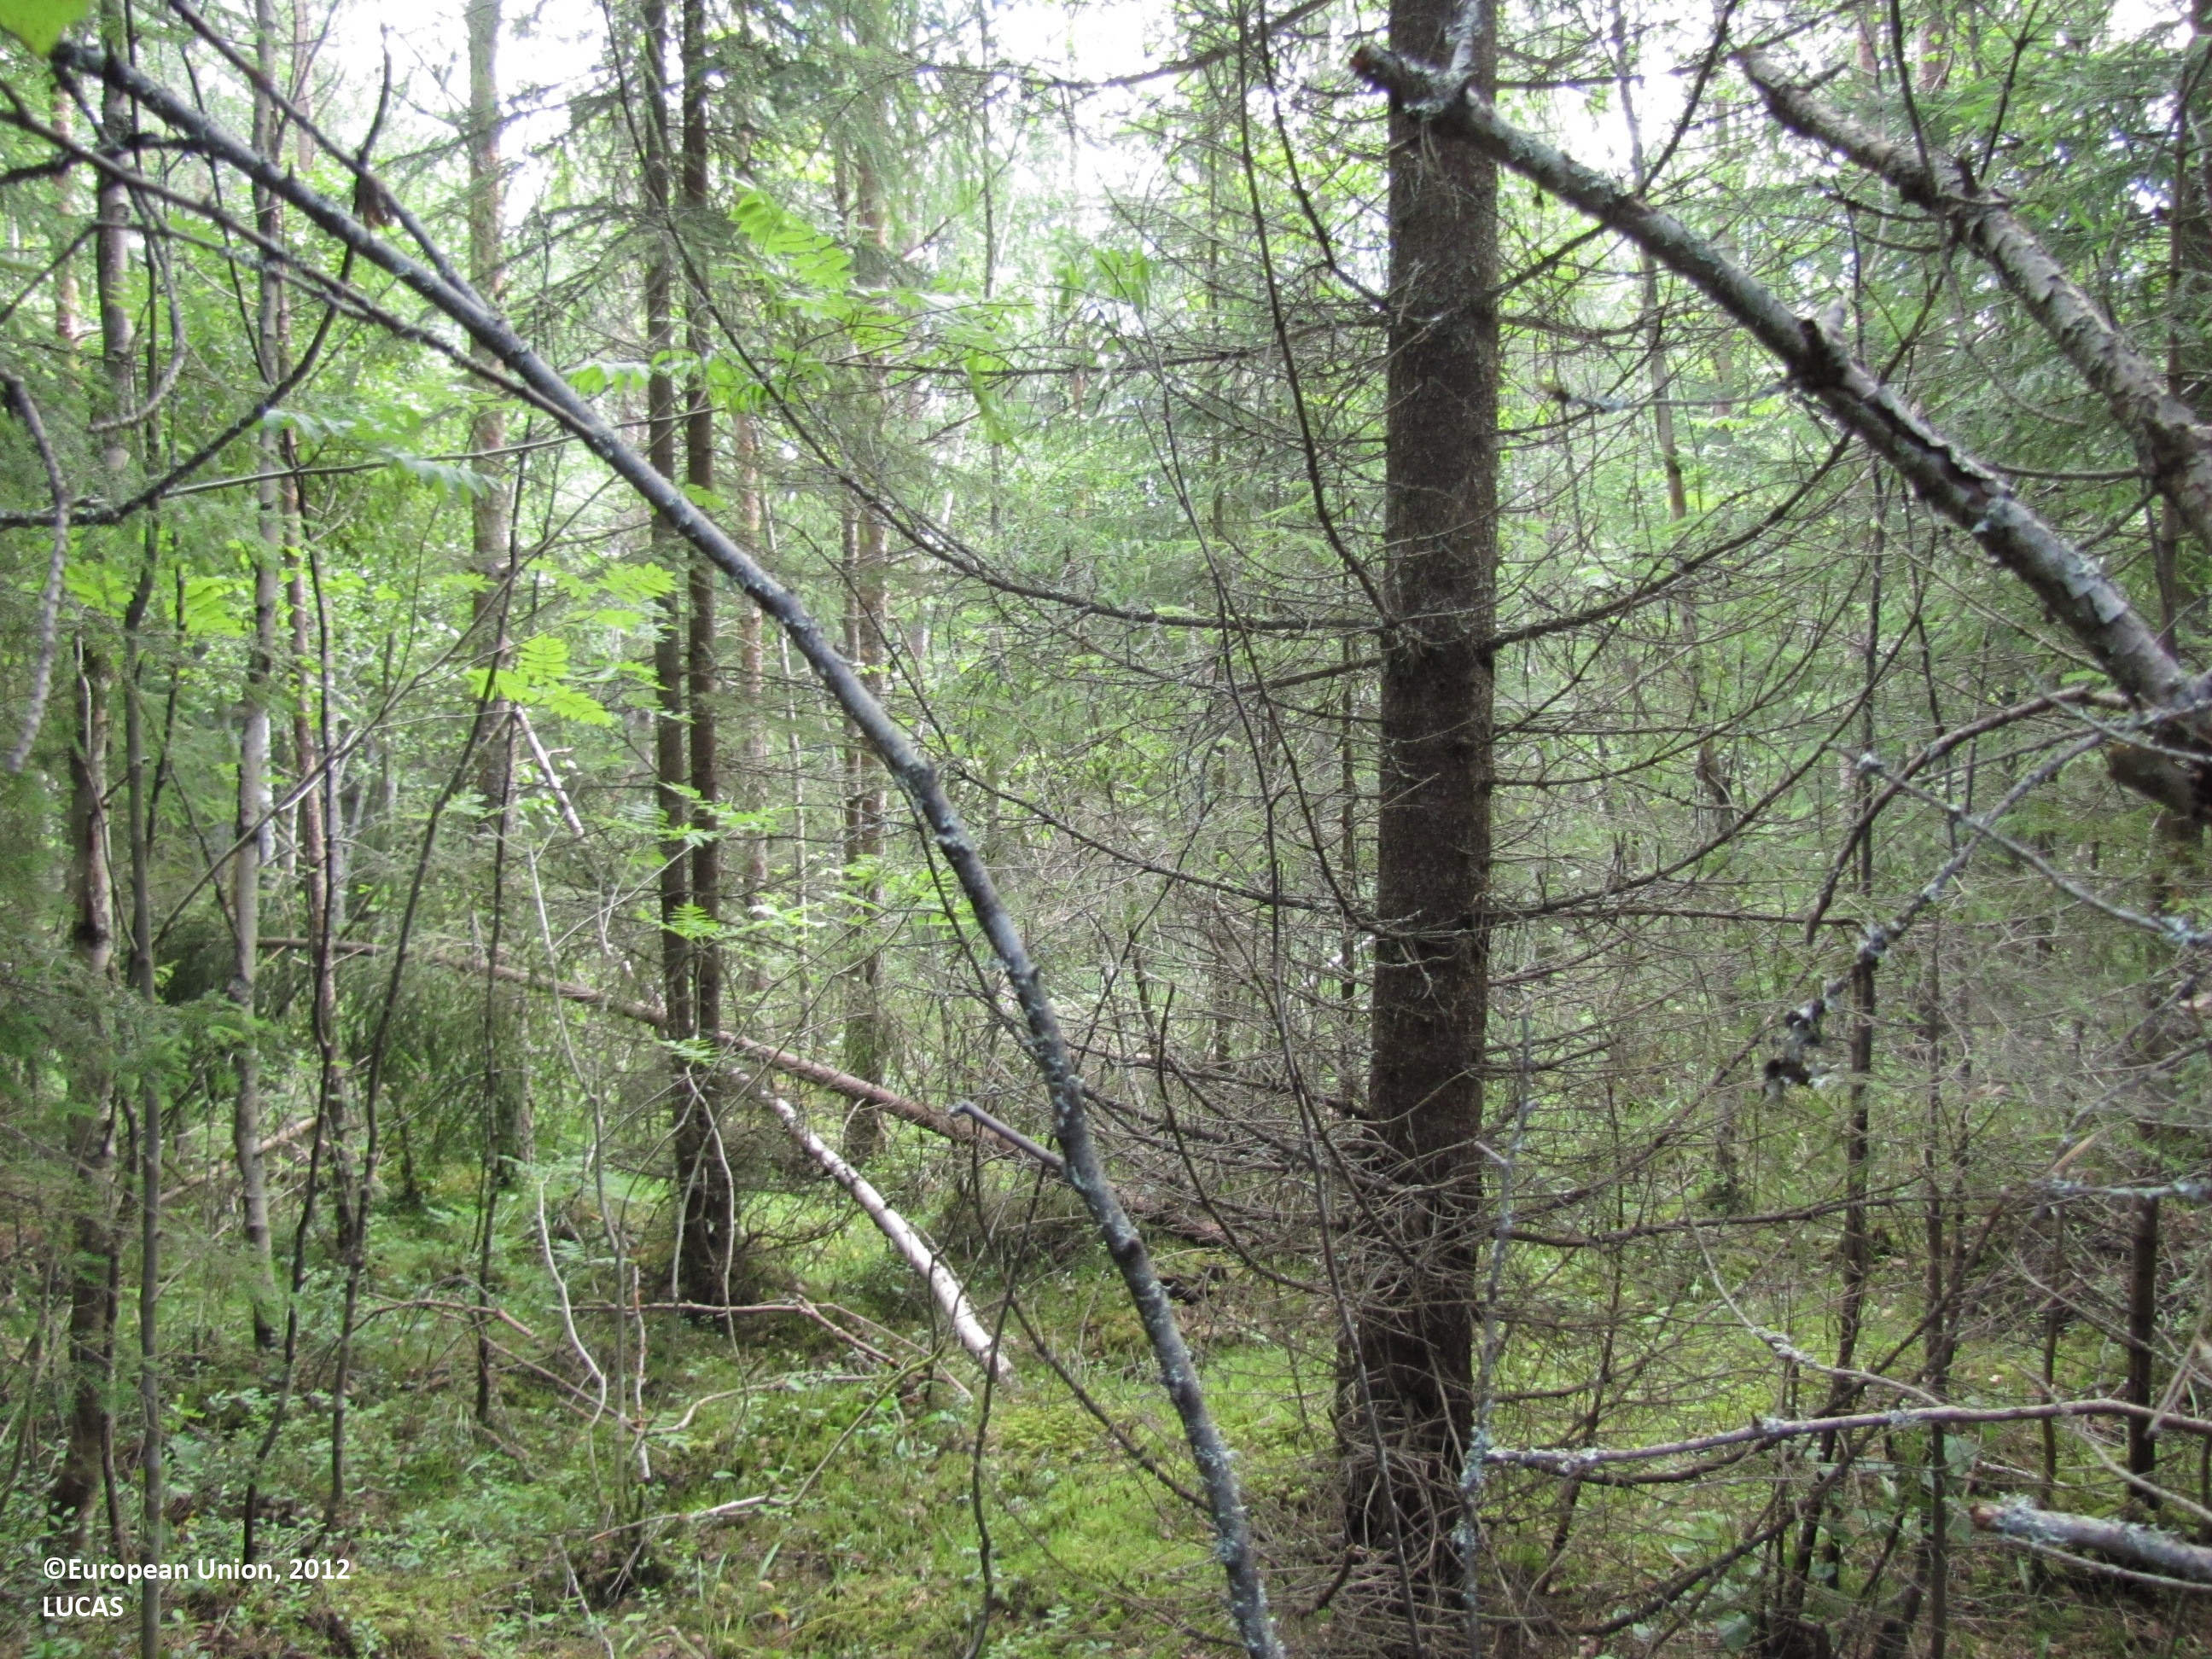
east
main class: Woodland
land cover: Spruce dominated mixed woodland
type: boreal forest
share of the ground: > 75 %
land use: Forestry
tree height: > 5 m
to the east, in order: Spruce dominated mixed woodland; Ditches and canals; Spruce dominated coniferous woodland; Pine dominated coniferous woodland; Inland water bodies; Inland marshes; Pine dominated coniferous woodland
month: July
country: FI
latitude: 62.0919
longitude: 23.3049
